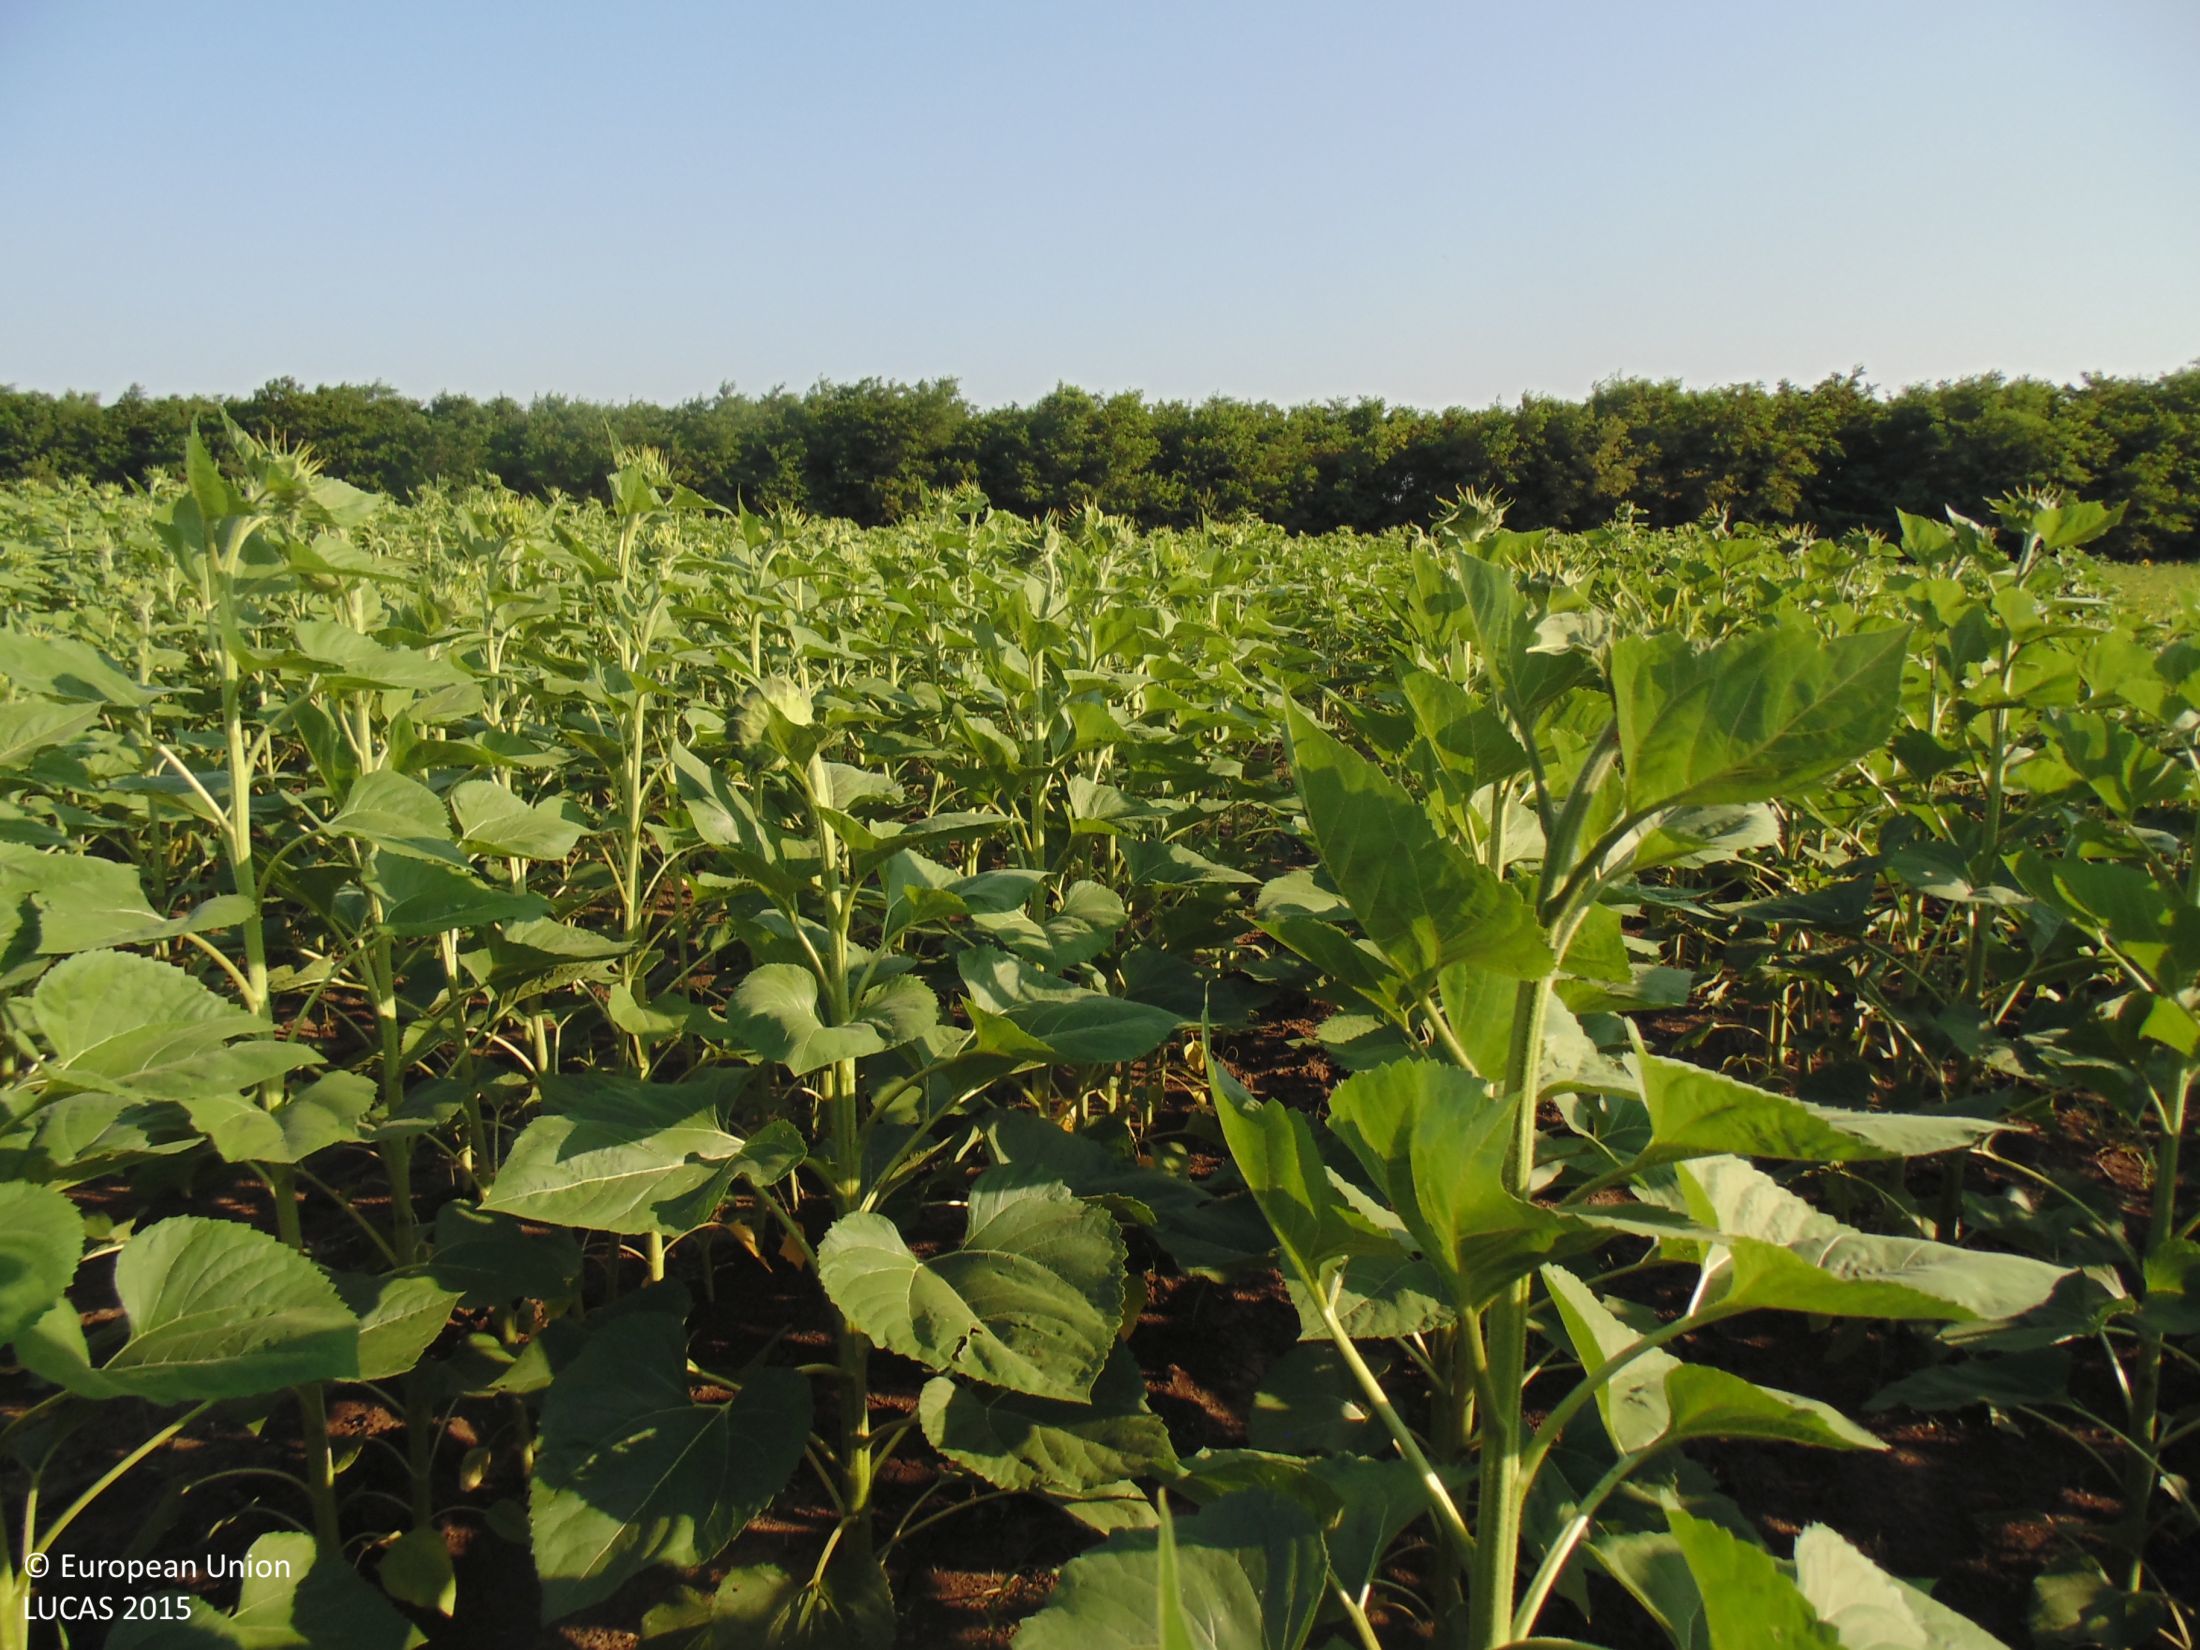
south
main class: Cropland
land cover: Sunflower
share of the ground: > 75 %
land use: Agriculture (excluding fallow land and kitchen gardens)
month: July
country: BG
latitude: 43.5130
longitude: 28.0212
